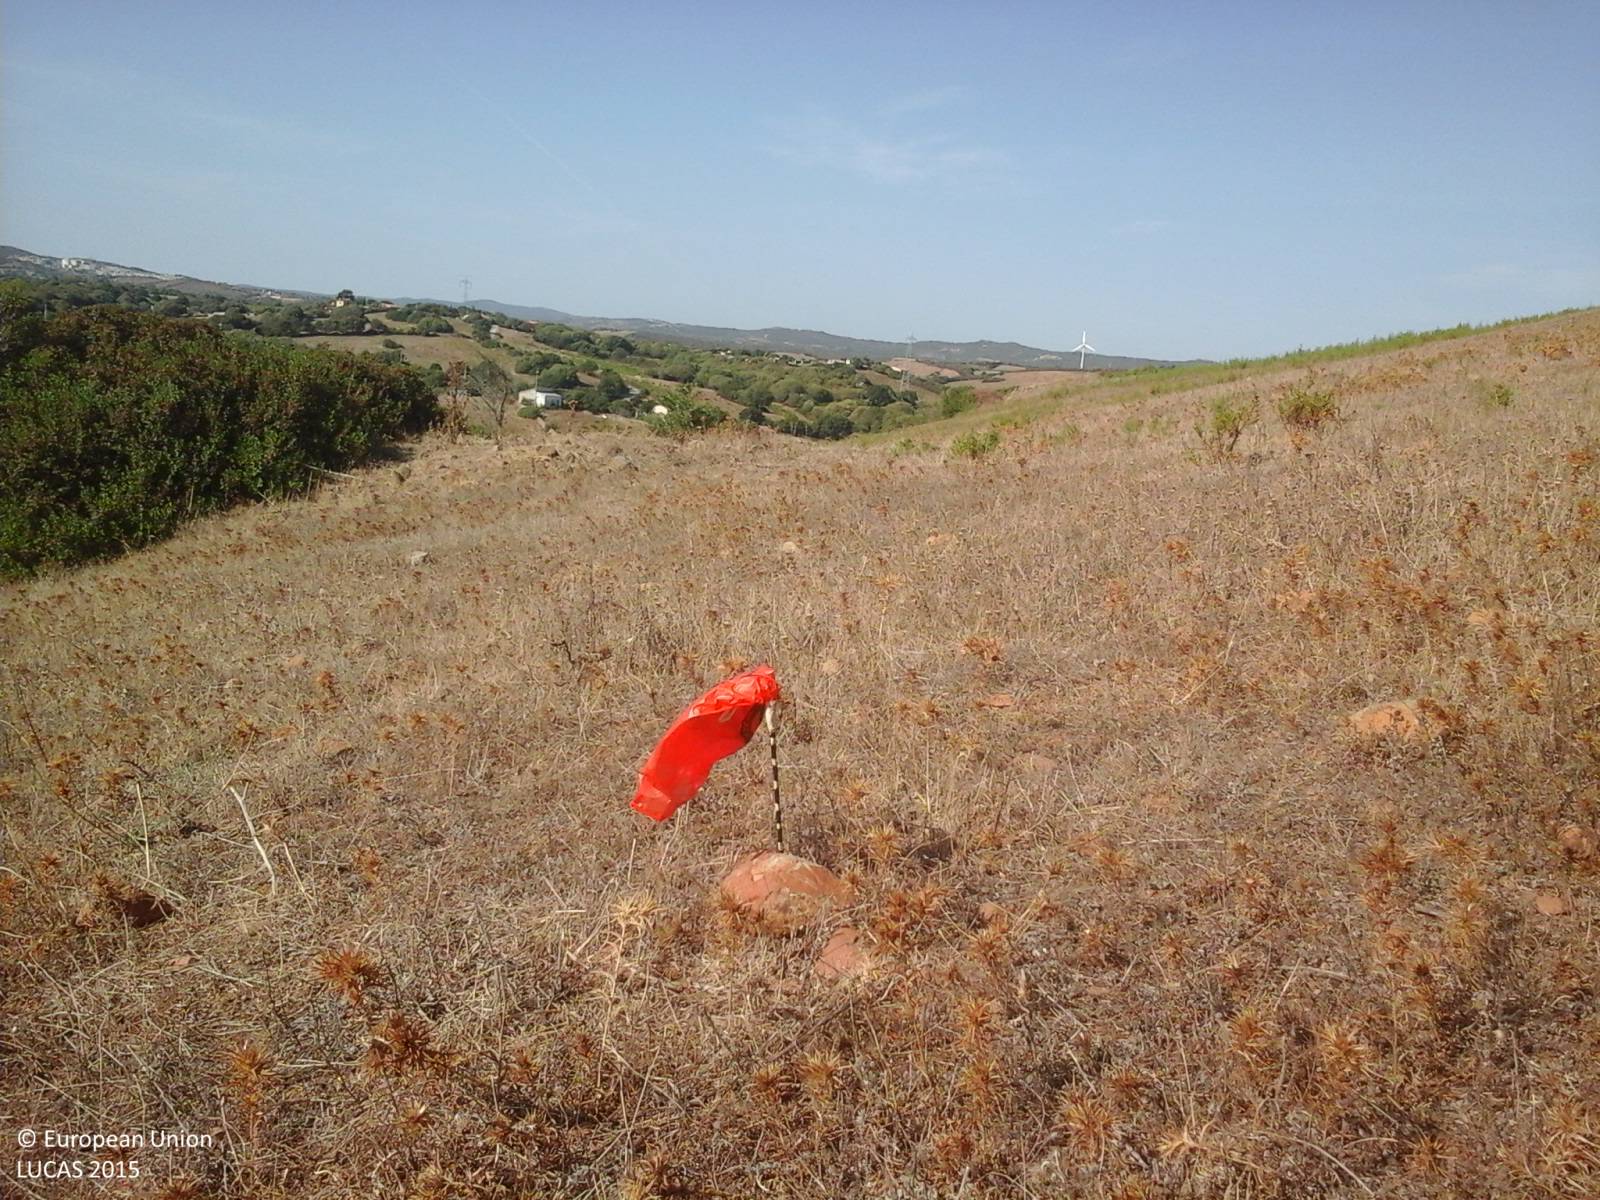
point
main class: Grassland
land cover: Grassland without tree/shrub cover
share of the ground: > 75 %
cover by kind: herbaceous plants 95 %, shrubs 5 %
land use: Agriculture (excluding fallow land and kitchen gardens)
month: September
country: IT
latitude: 41.1148
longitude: 9.2294
